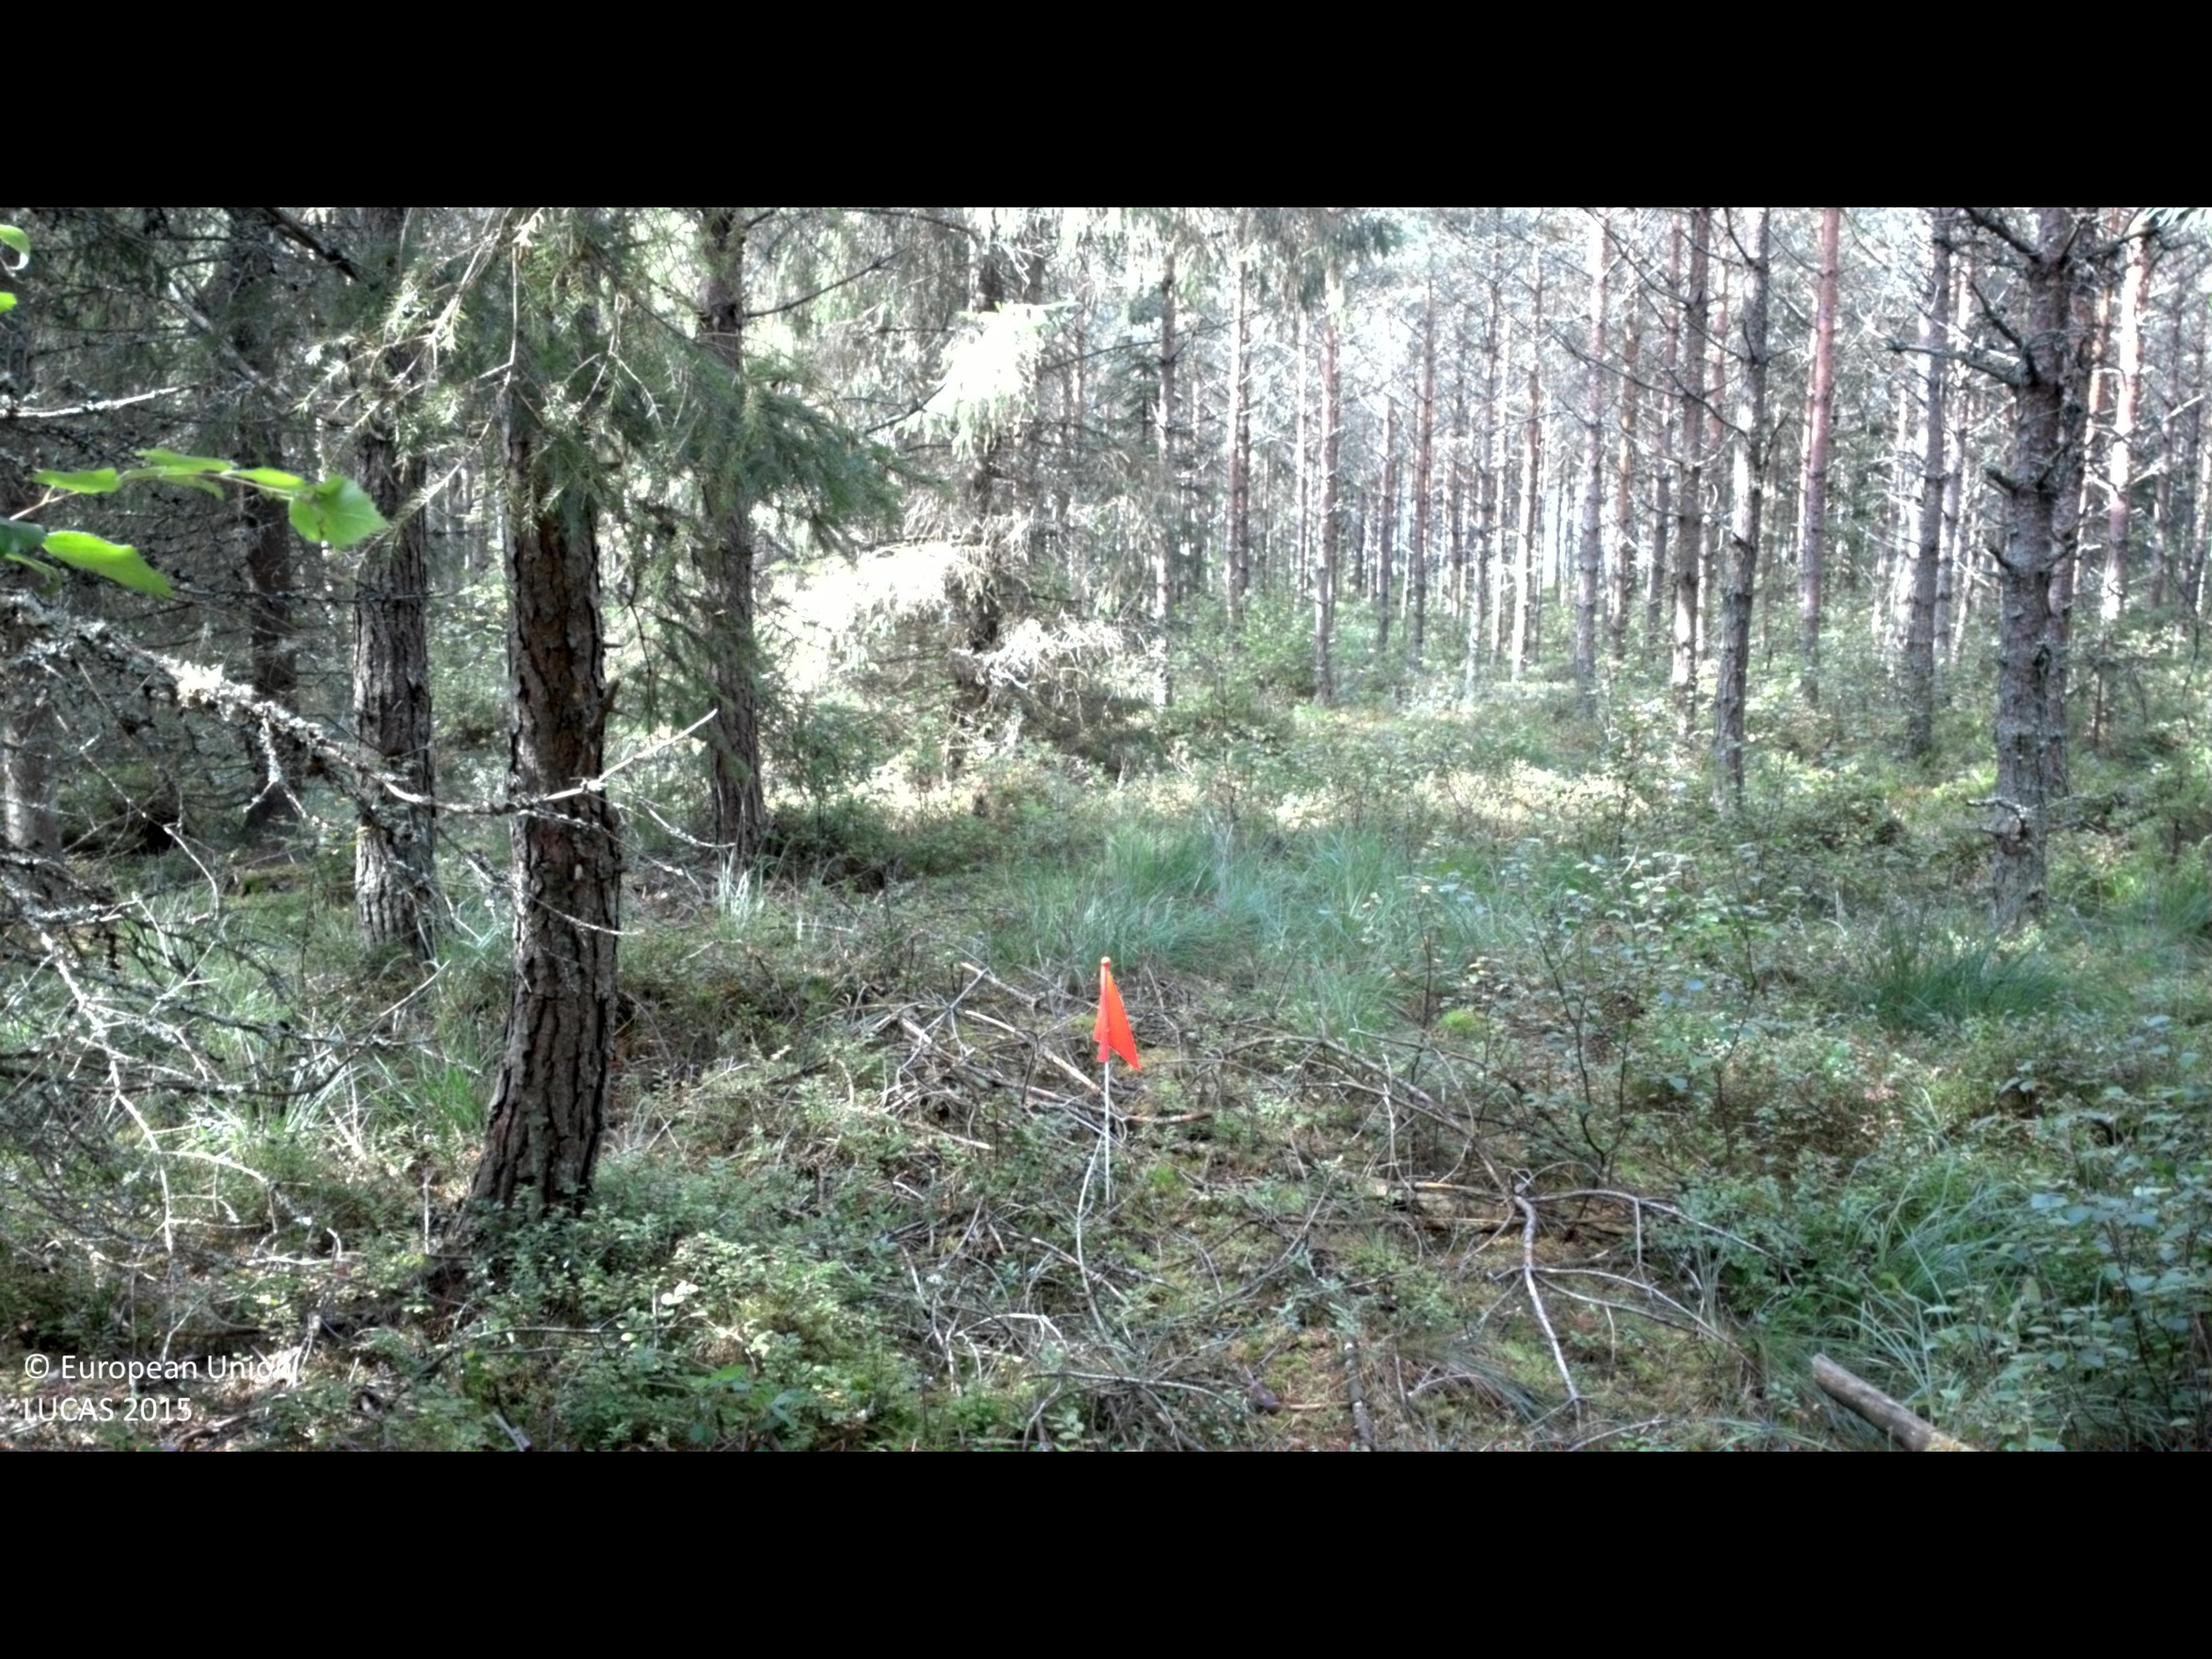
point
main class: Woodland
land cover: Pine dominated coniferous woodland
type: boreal forest
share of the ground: 50 - 75 %
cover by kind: coniferous forest trees 60 %, shrubs 20 %, herbaceous plants 15 %, broadleaved forest trees 5 %
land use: Forestry
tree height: > 5 m
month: August
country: SE
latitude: 57.1392
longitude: 13.8132
